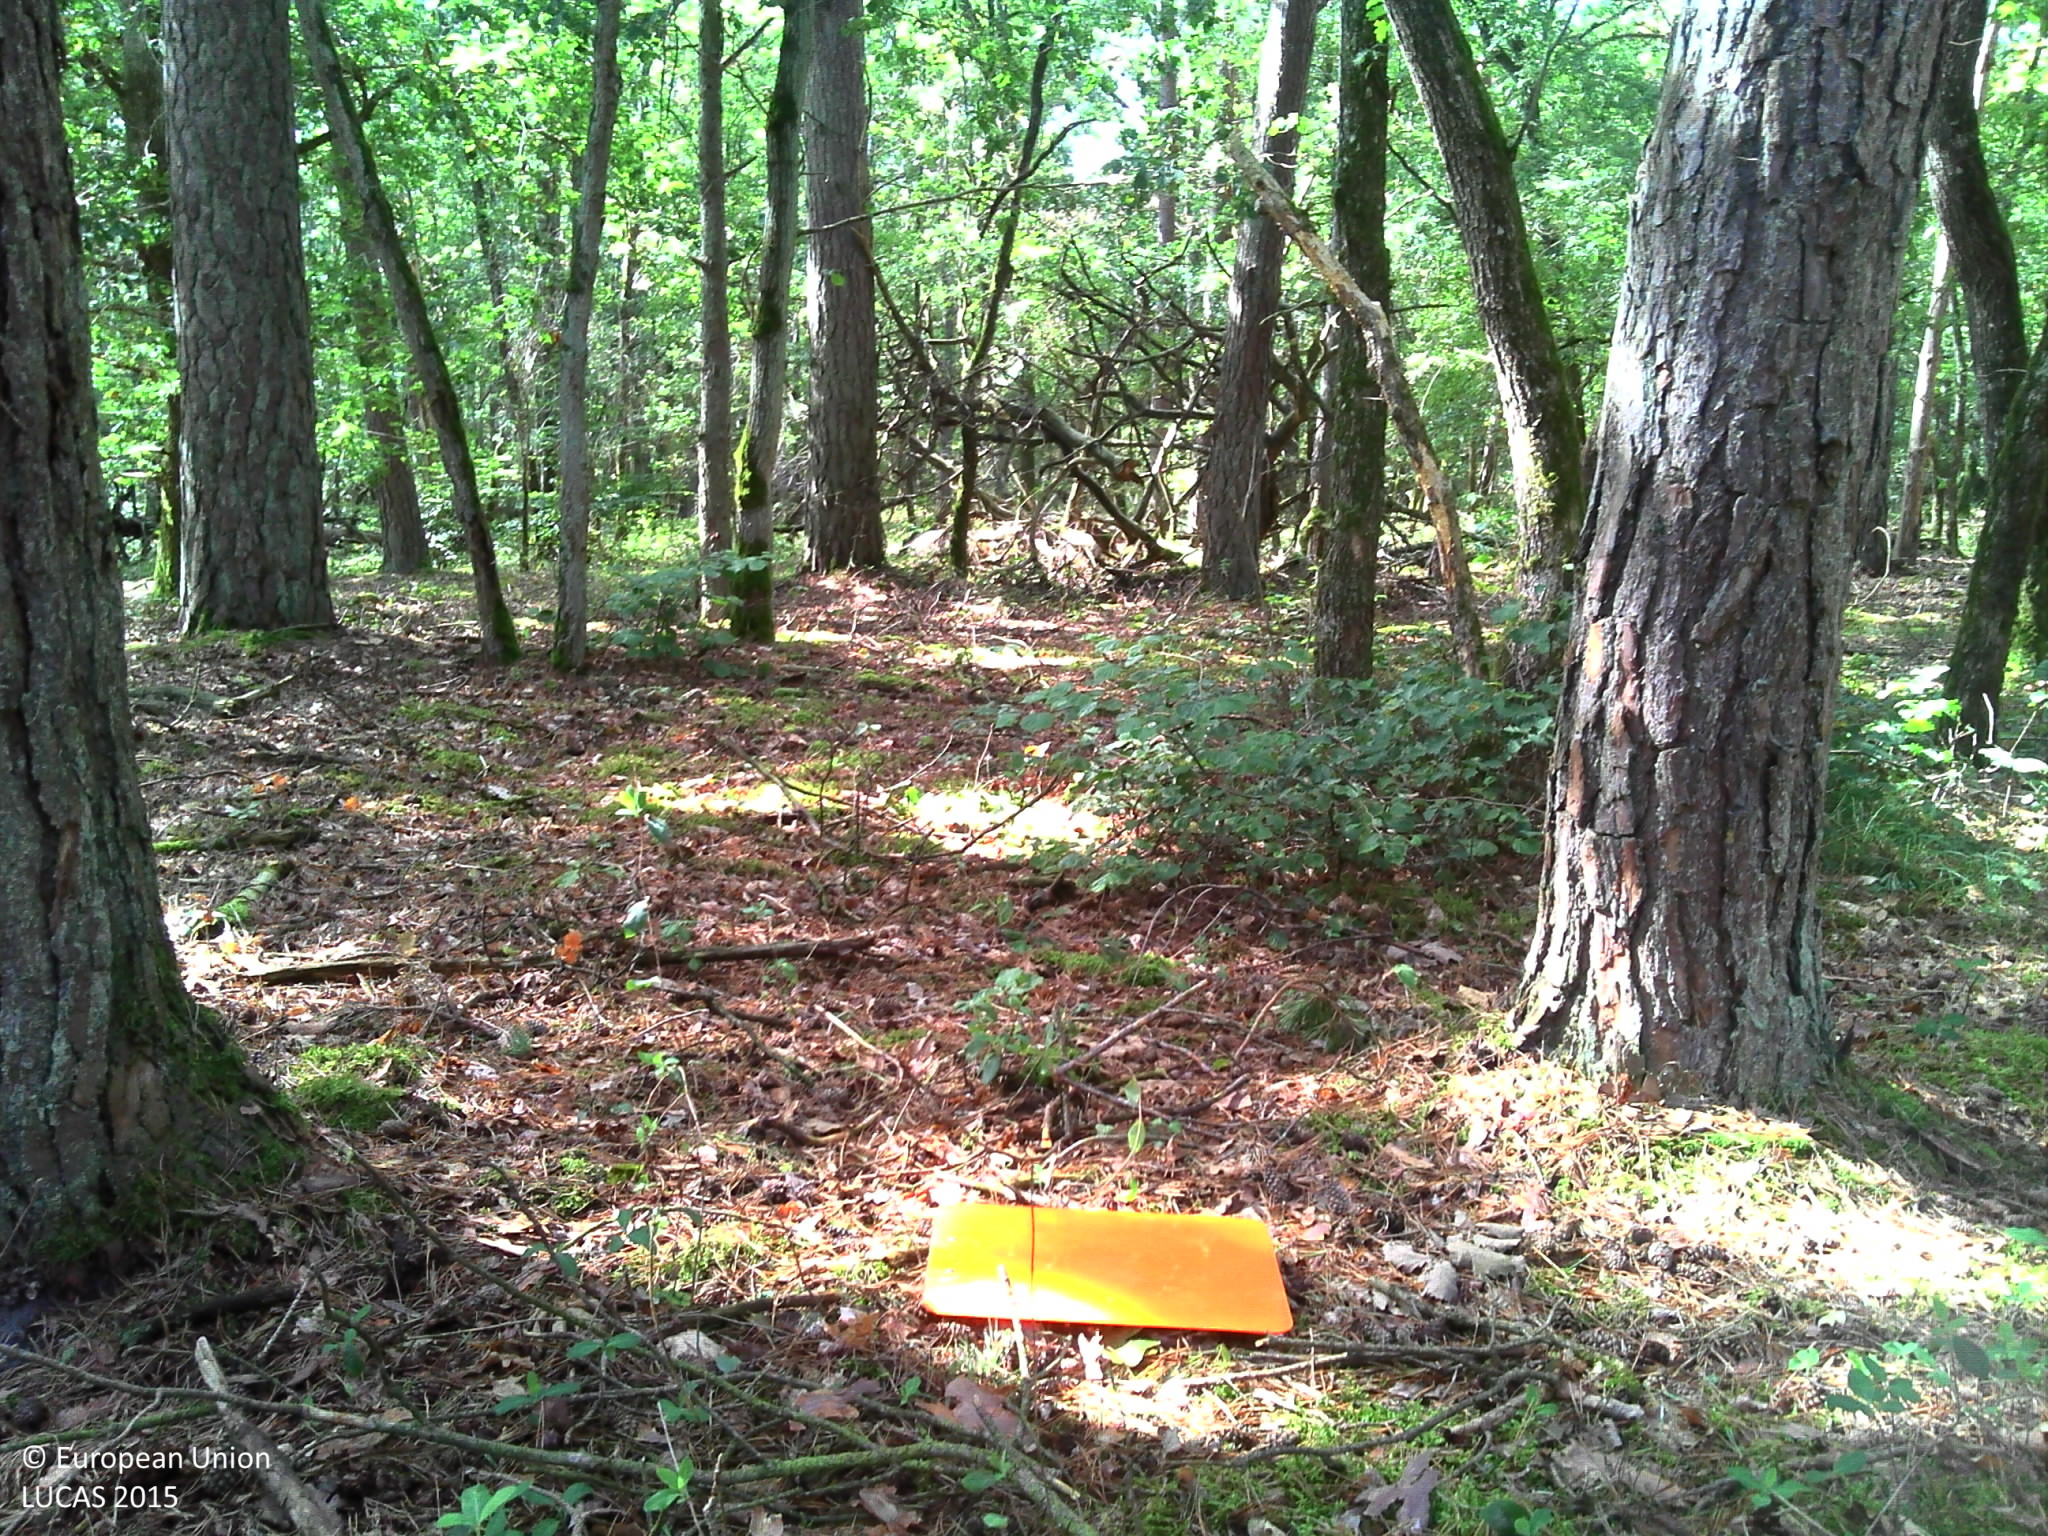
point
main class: Woodland
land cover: Pine dominated mixed woodland
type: acidophilous oak and oak-birch forest
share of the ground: > 75 %
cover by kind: coniferous forest trees 50 %, broadleaved forest trees 40 %, herbaceous plants 5 %, lichens and mosses 5 %
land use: Forestry
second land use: Amenities, museums, leisure
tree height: > 5 m
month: September
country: FR
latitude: 48.2383
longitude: 2.7608
